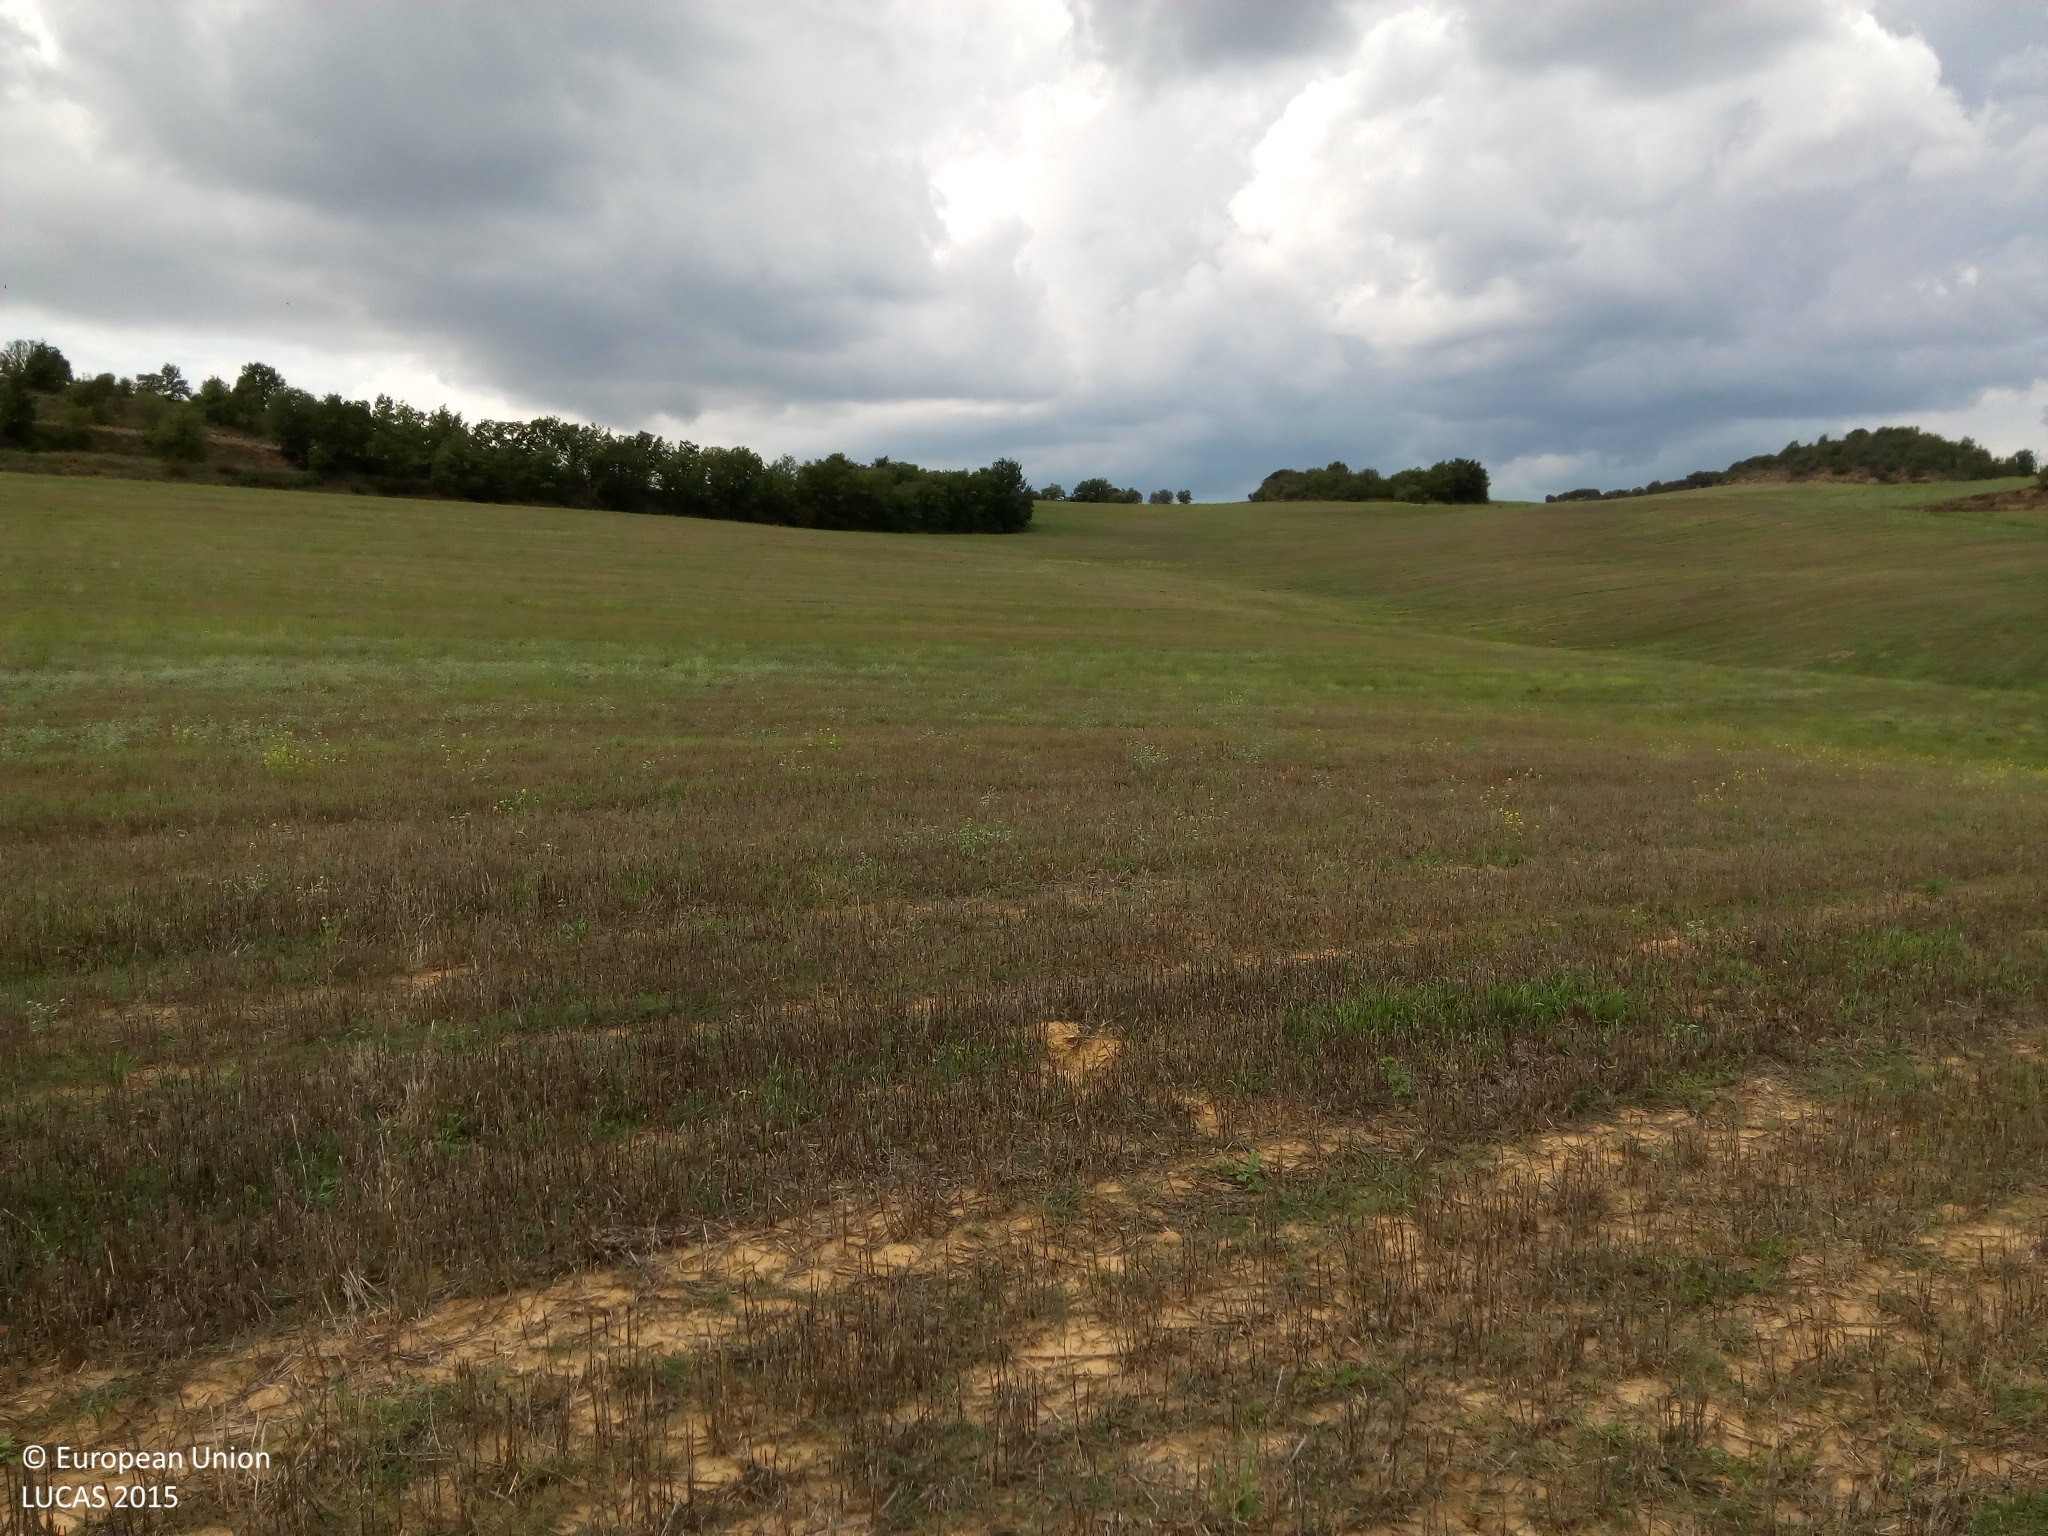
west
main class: Grassland
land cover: Spontaneously vegetated surfaces
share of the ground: > 75 %
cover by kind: unconsolidated bare surface 60 %, herbaceous plants 40 %
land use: Fallow land
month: August
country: ES
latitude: 42.0655
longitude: 0.5453
